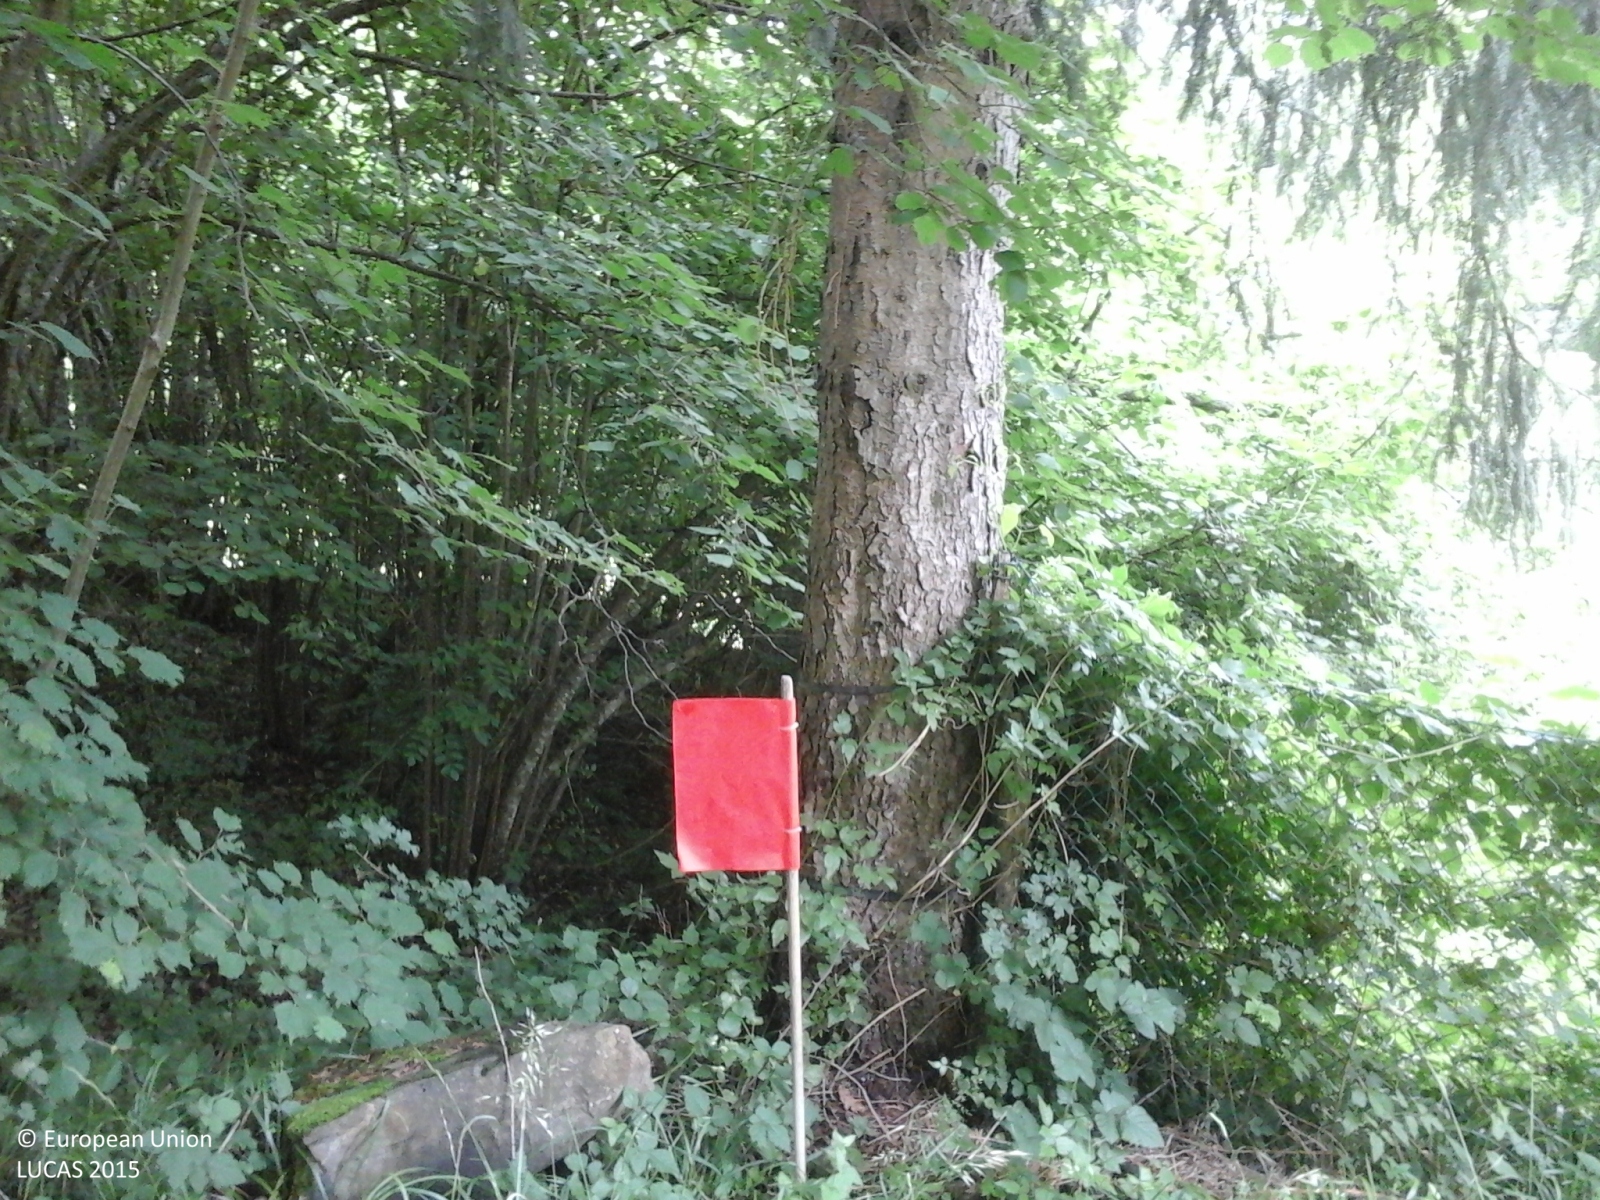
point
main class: Woodland
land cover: Broadleaved woodland
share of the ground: > 75 %
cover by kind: broadleaved forest trees 80 %, coniferous forest trees 20 %
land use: Forestry
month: June
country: IT
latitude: 44.5662
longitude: 9.6105
